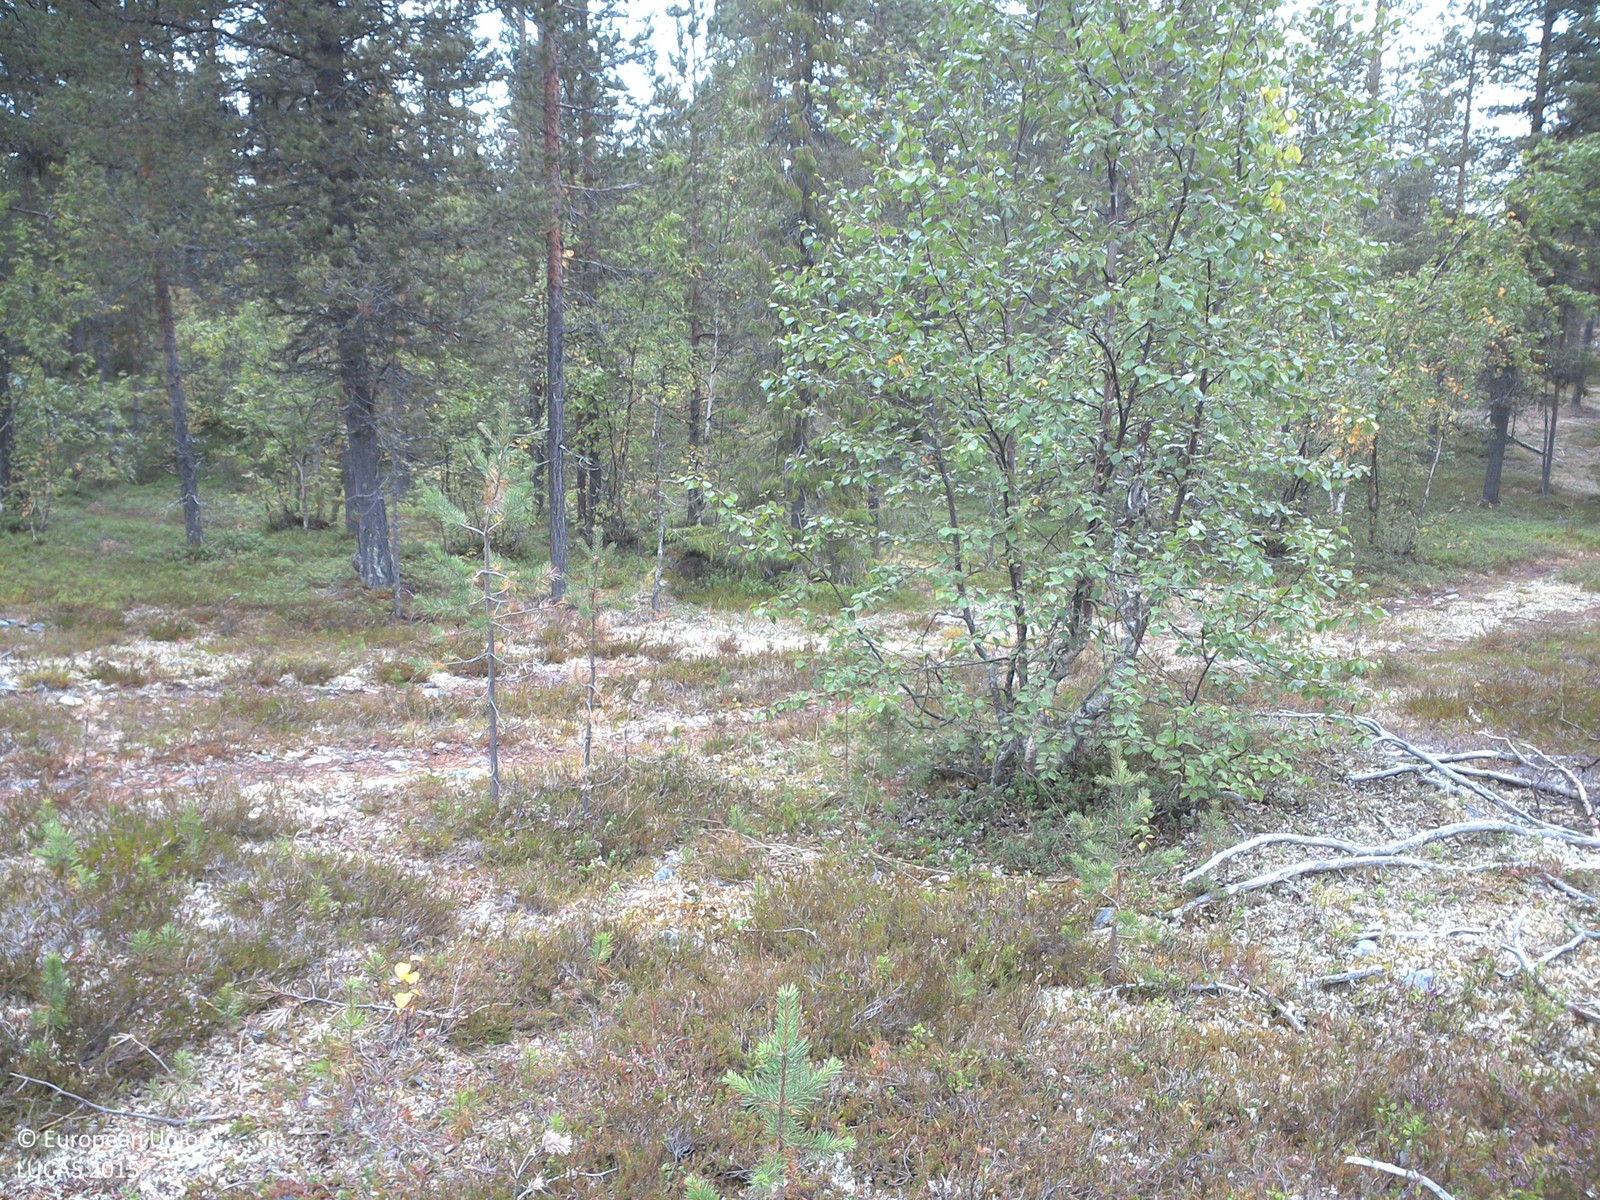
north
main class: Woodland
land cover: Pine dominated coniferous woodland
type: boreal forest
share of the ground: 10 - 25 %
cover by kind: shrubs 50 %, lichens and mosses 35 %, coniferous forest trees 15 %
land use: Forestry
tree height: > 5 m
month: August
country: SE
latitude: 67.9479
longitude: 23.2048
